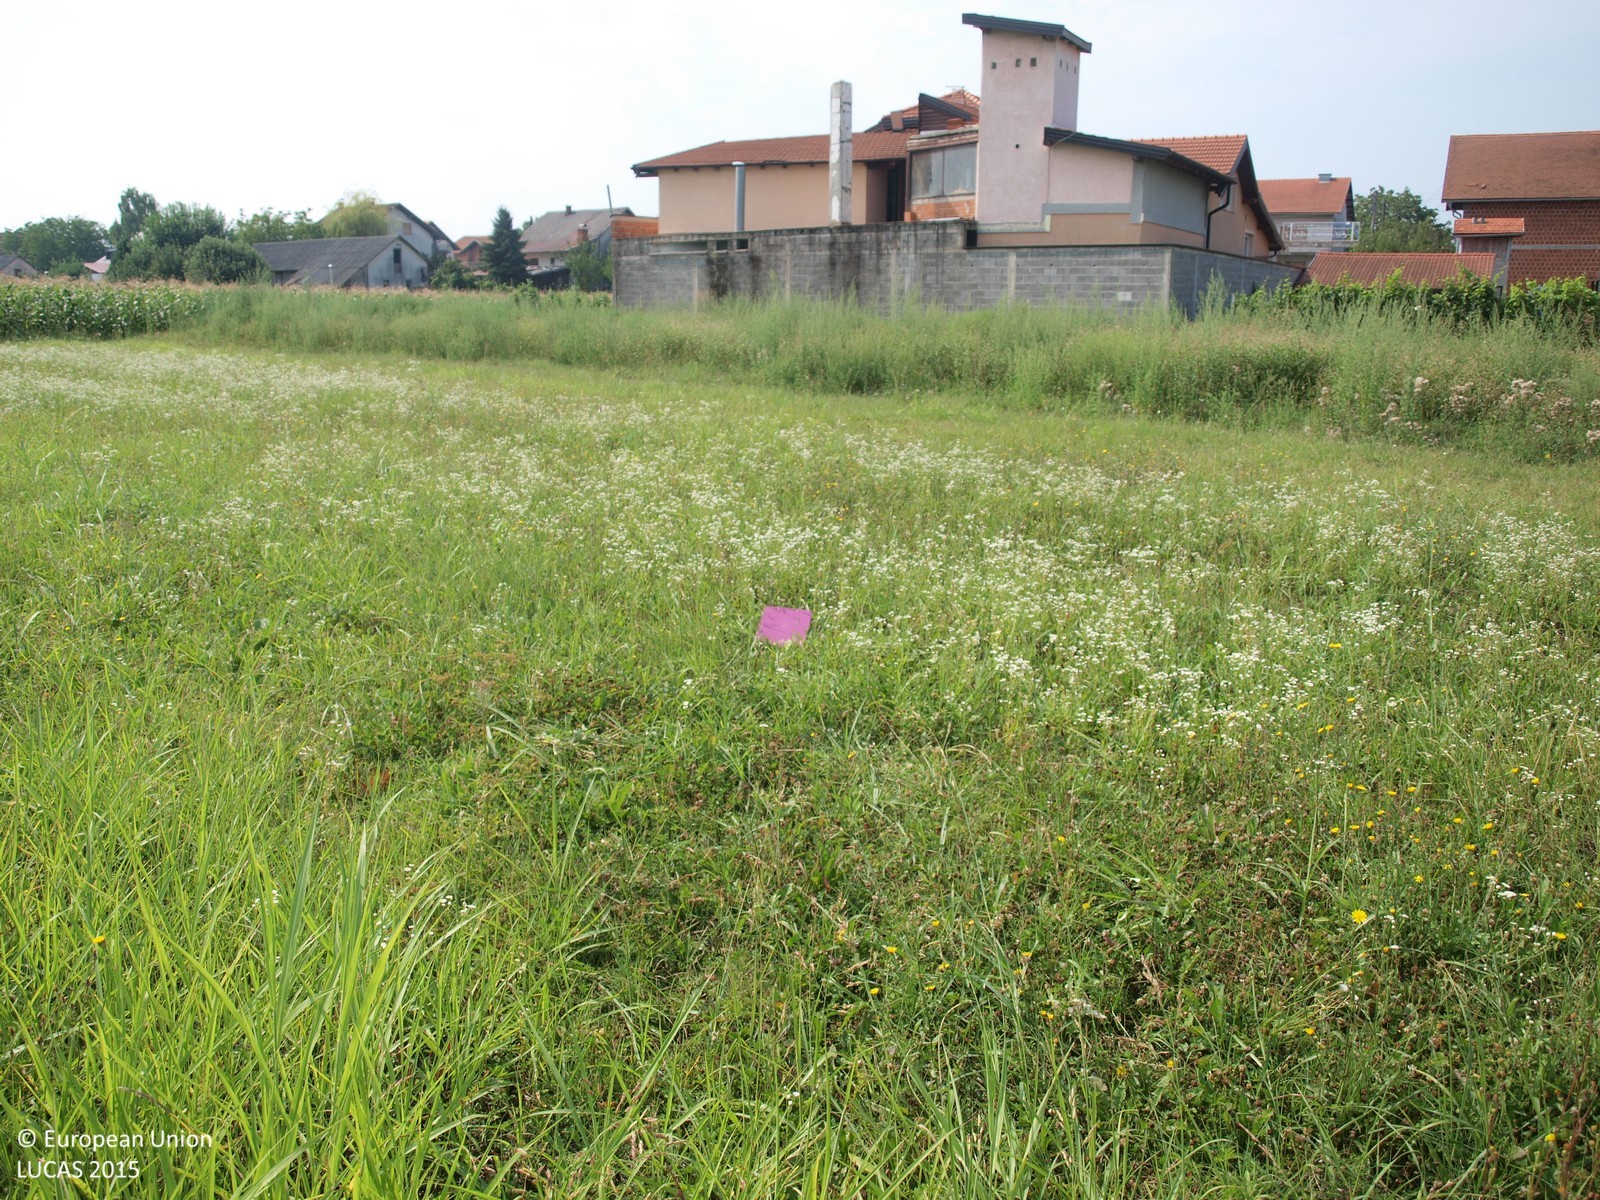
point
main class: Grassland
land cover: Grassland without tree/shrub cover
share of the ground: > 75 %
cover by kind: herbaceous plants 100 %
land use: Agriculture (excluding fallow land and kitchen gardens)
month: August
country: HR
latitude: 45.7758
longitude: 15.8491
